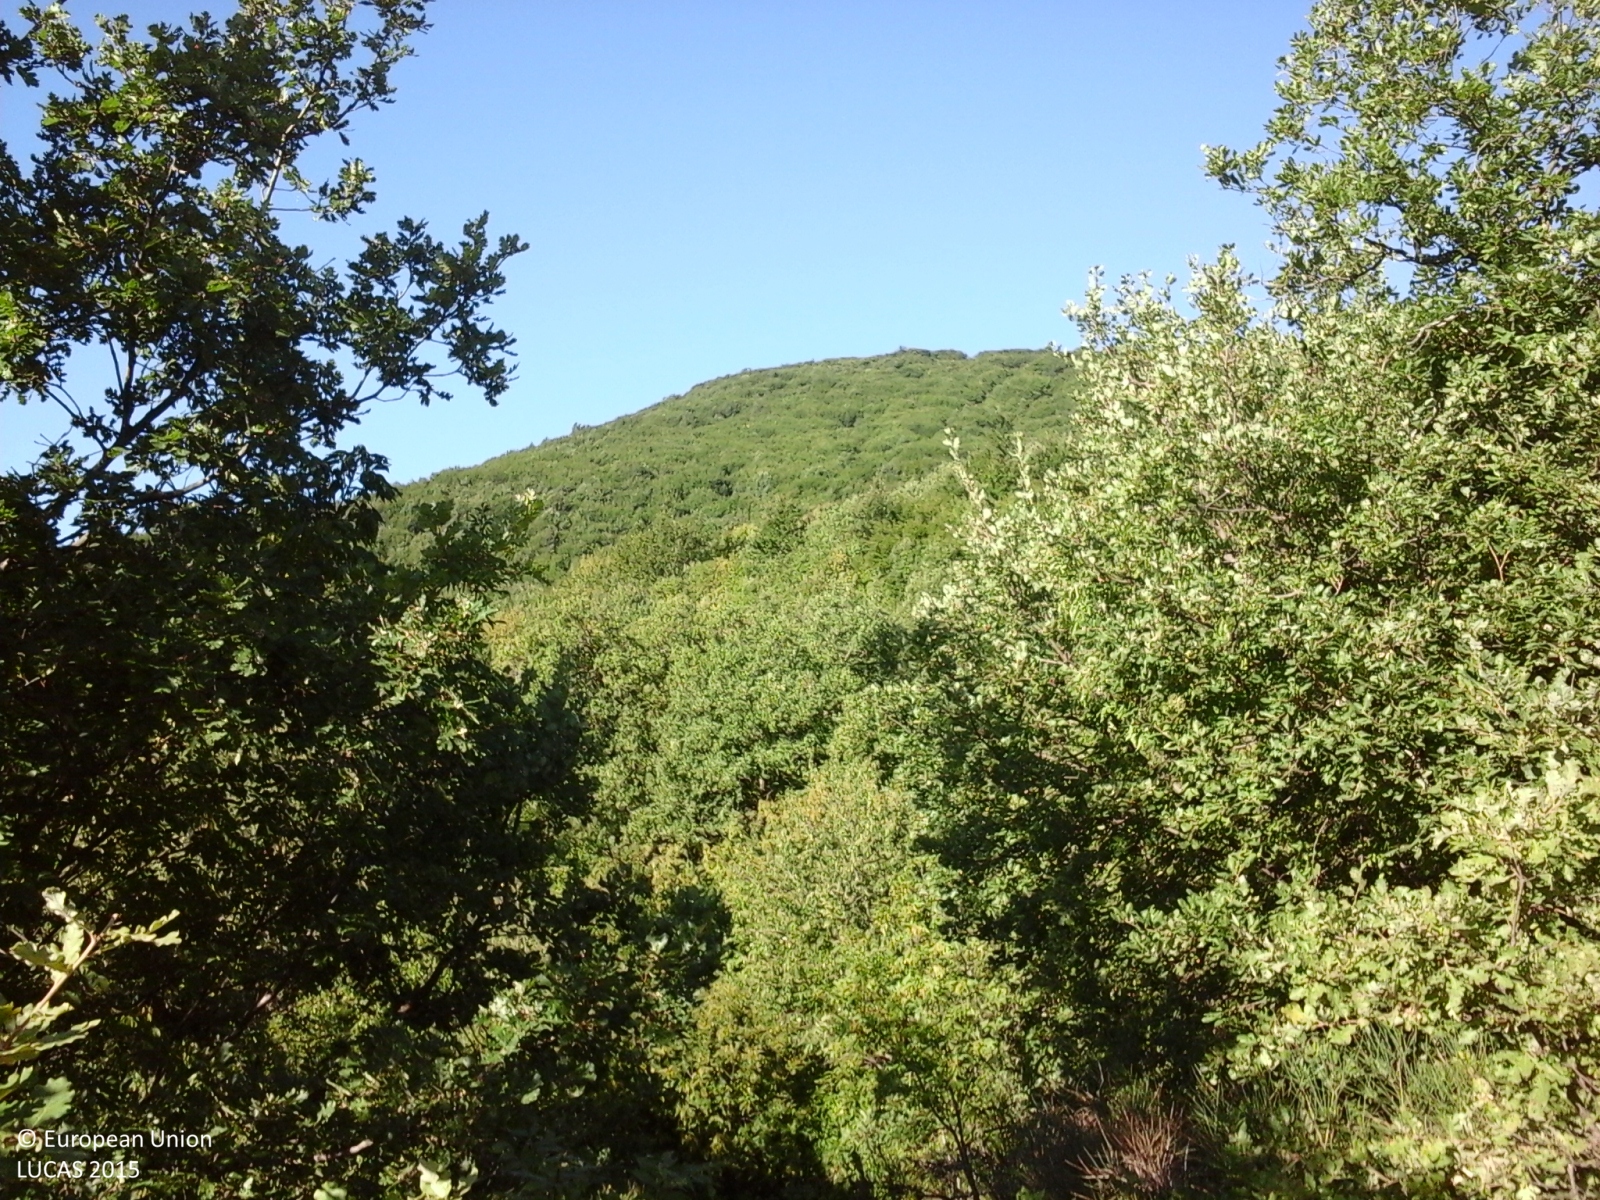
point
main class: Woodland
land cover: Broadleaved woodland
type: thermophilous deciduous forest
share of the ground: > 75 %
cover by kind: broadleaved forest trees 95 %, coniferous forest trees 5 %
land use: Forestry
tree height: > 5 m
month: August
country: IT
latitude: 43.1515
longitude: 13.0045
